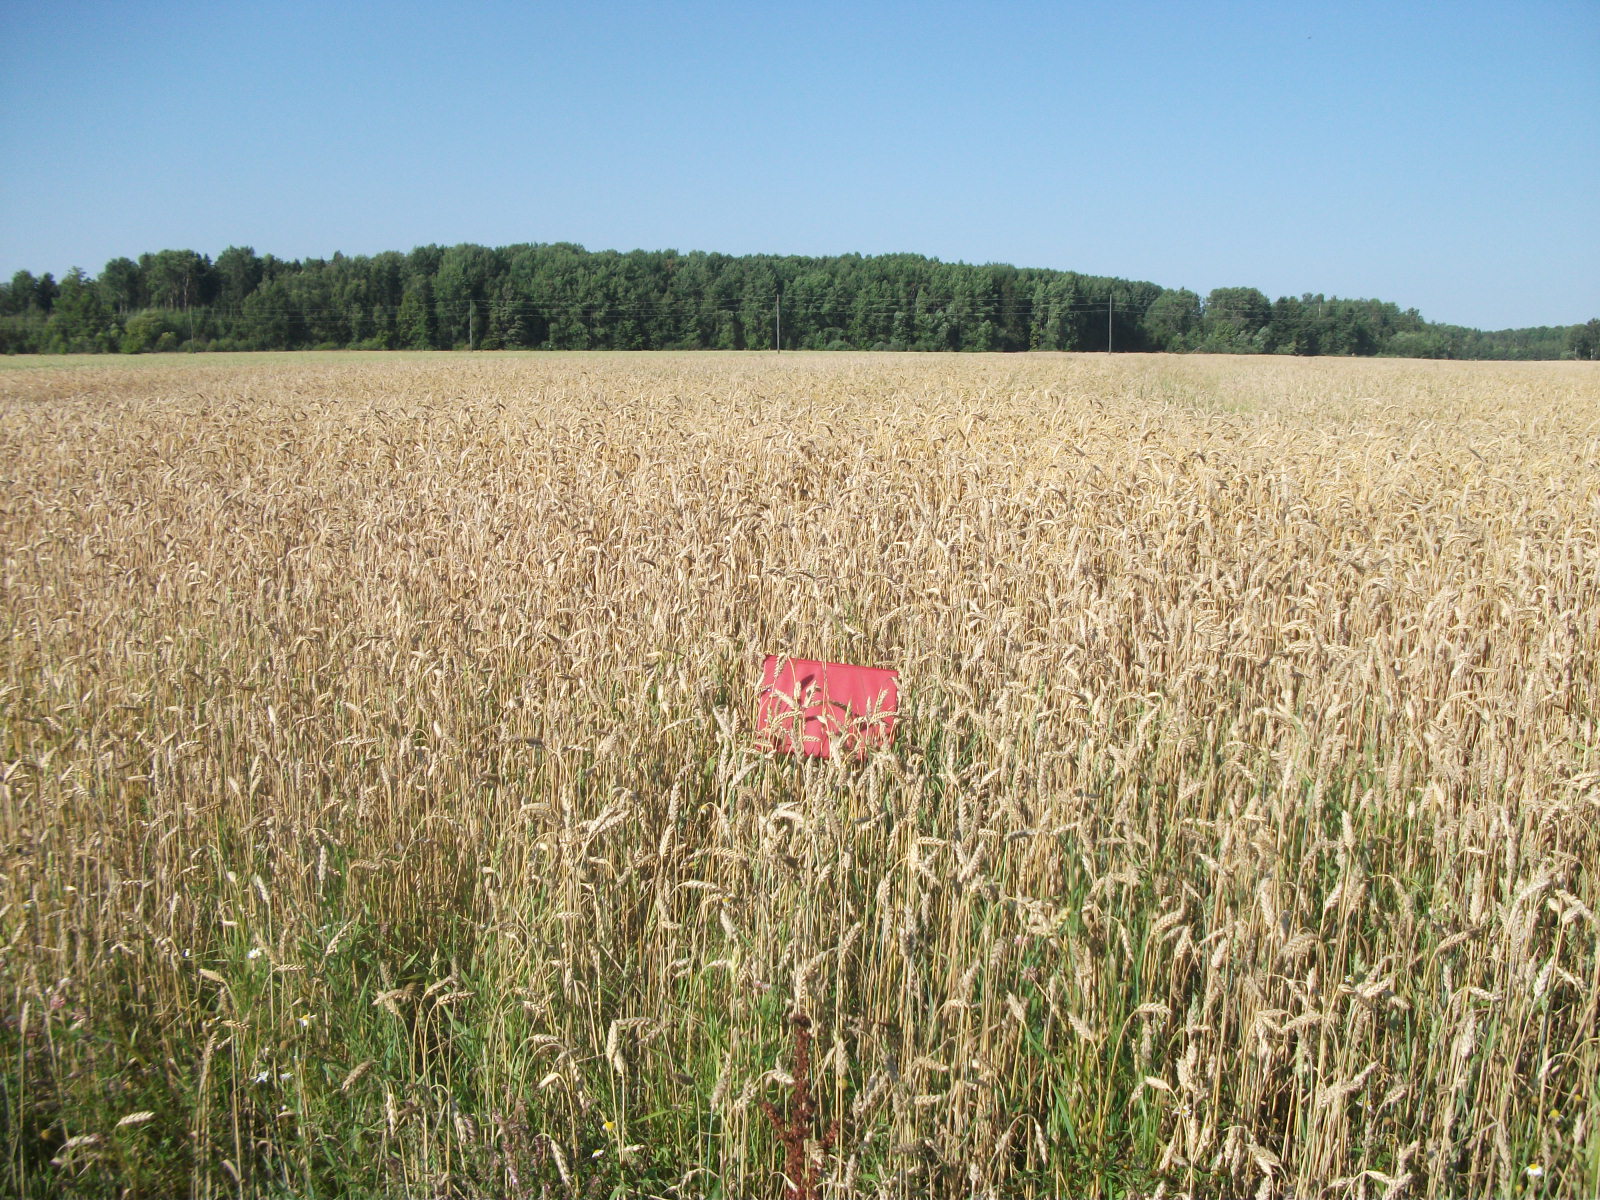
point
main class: Cropland
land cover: Common wheat
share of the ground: > 75 %
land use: Agriculture (excluding fallow land and kitchen gardens)
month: August
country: LV
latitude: 56.7323
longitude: 26.6098
